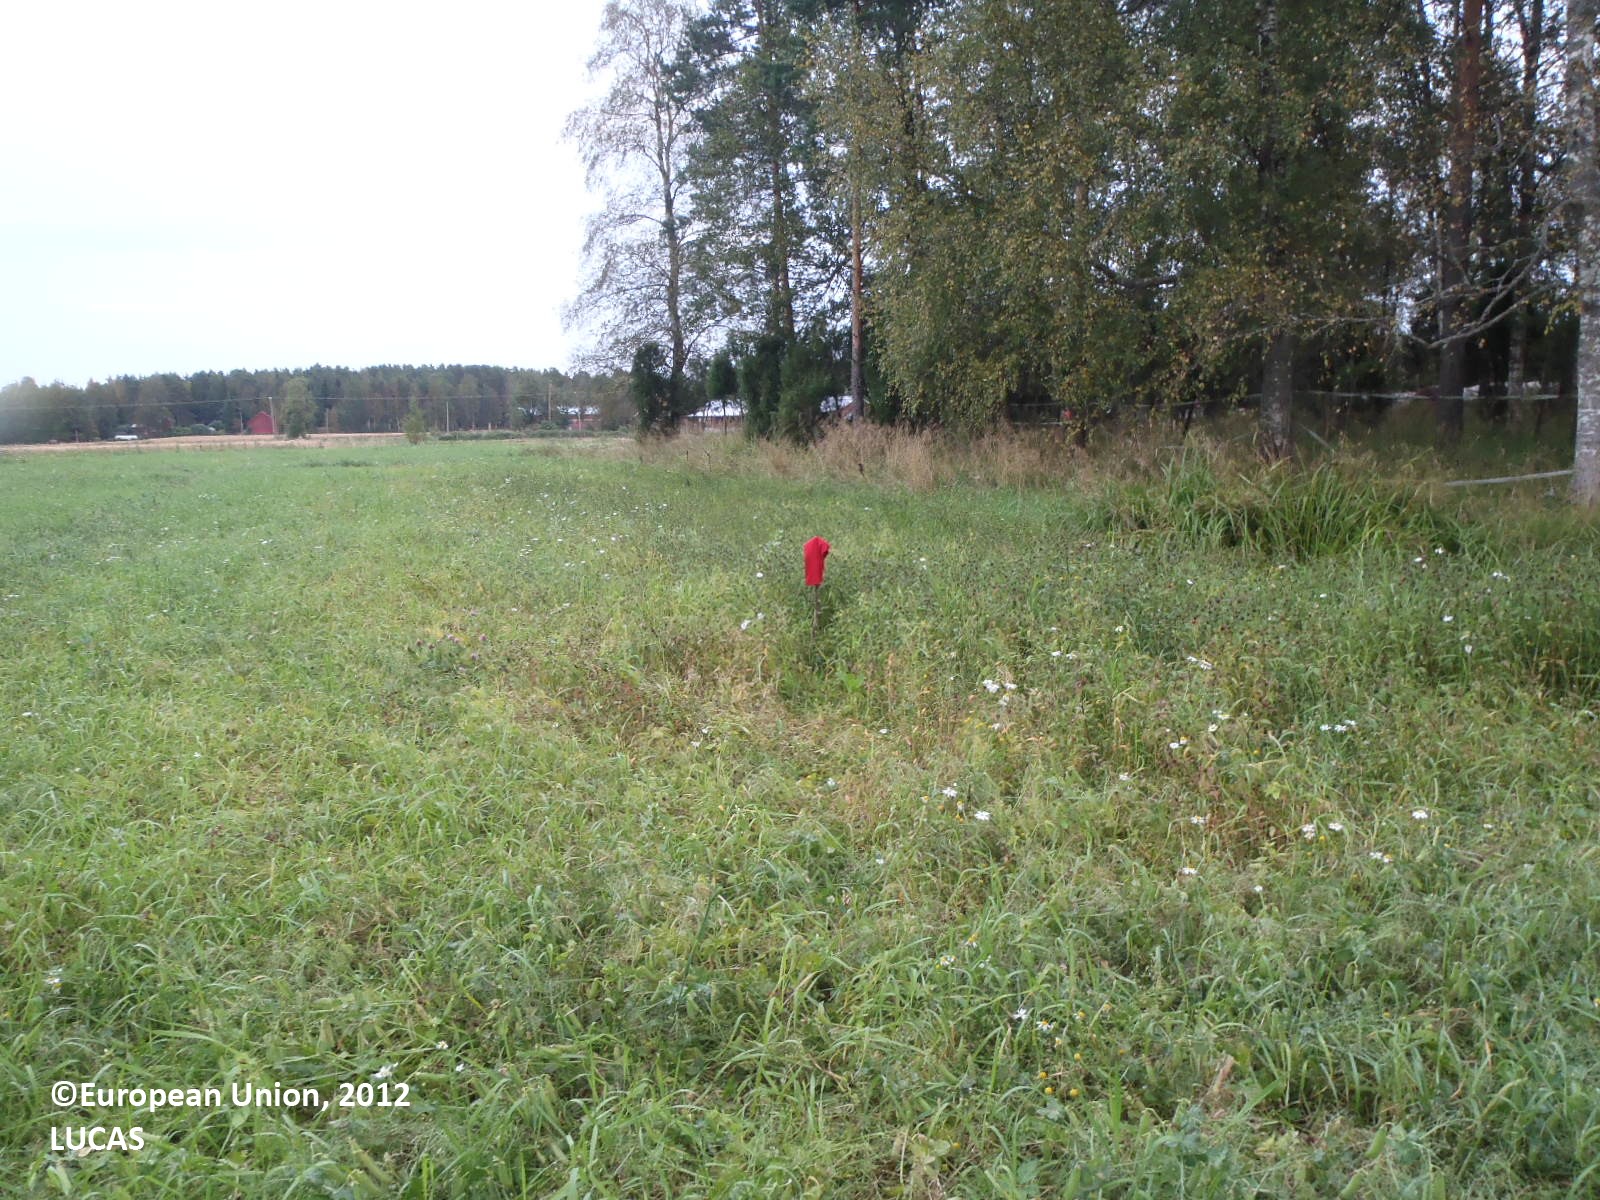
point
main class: Cropland
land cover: Mixed cereals for fodder
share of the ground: > 75 %
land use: Agriculture (excluding fallow land and kitchen gardens)
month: August
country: FI
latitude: 60.9205
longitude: 22.4805
